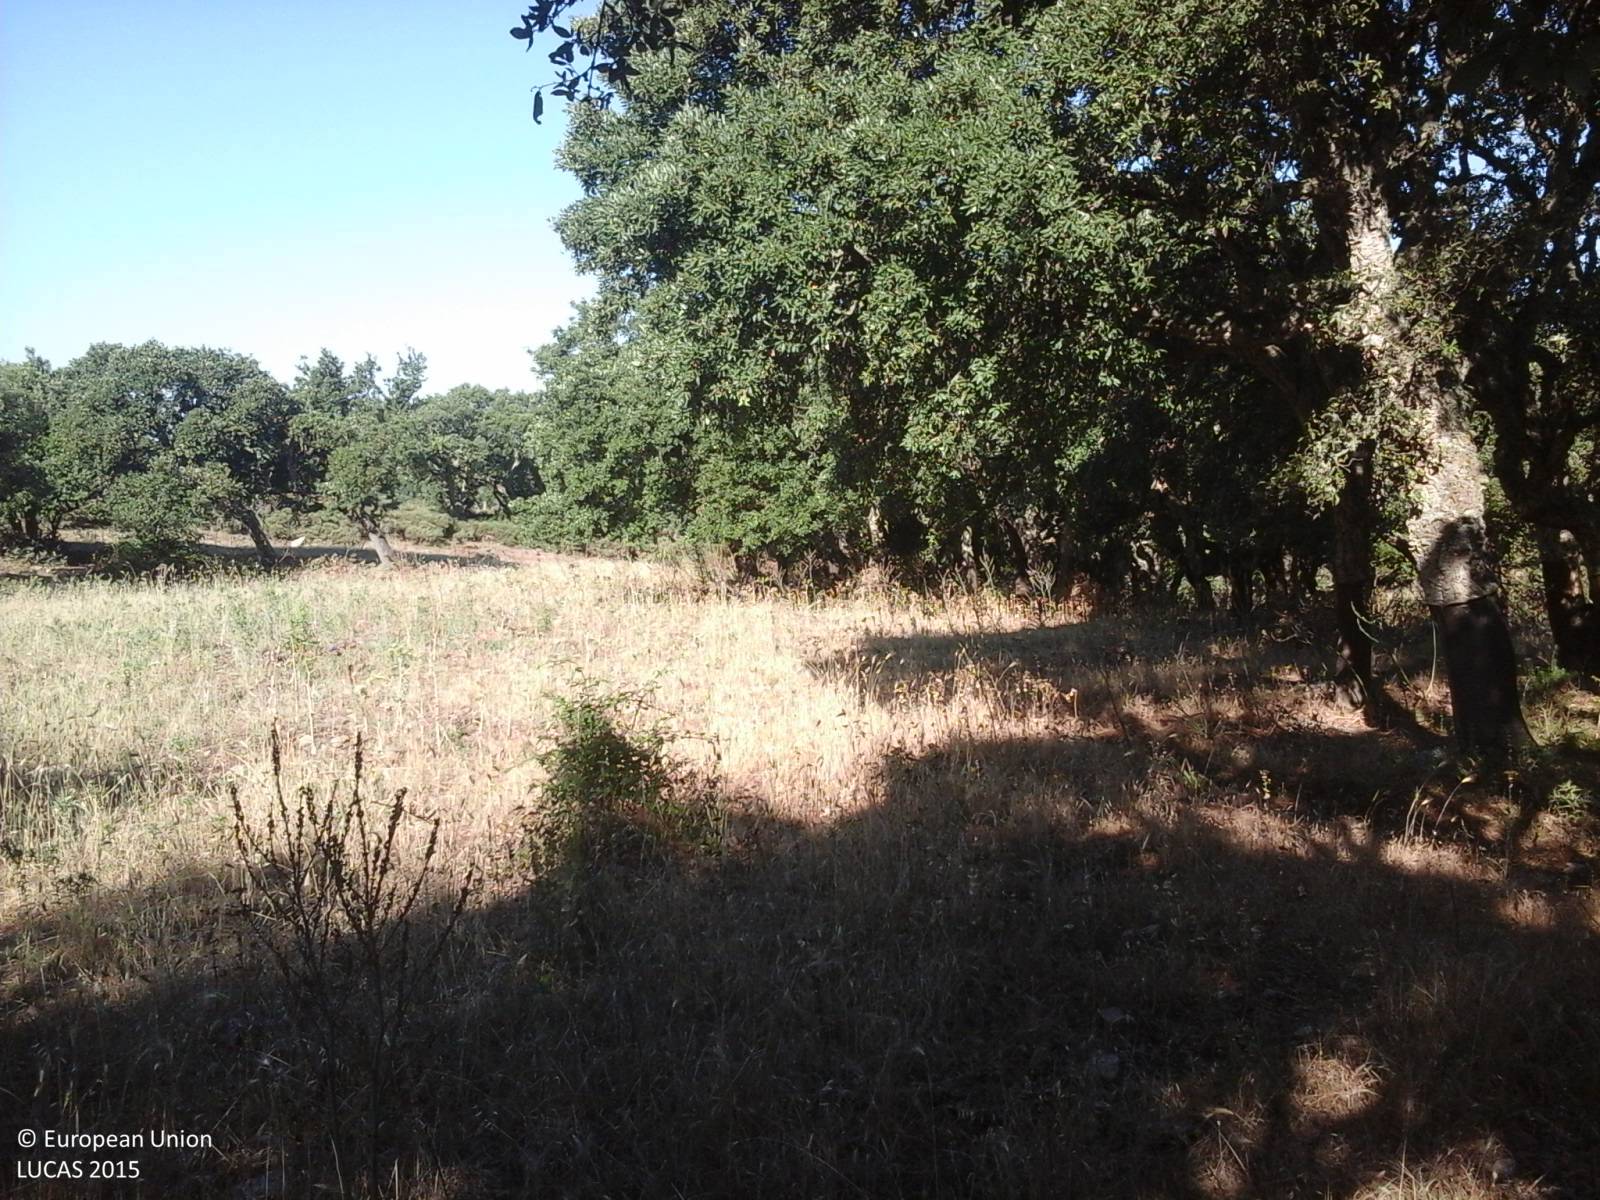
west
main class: Woodland
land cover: Broadleaved woodland
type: broadleaved evergreen forest
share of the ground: > 75 %
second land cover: Grassland without tree/shrub cover
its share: < 10 %
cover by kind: broadleaved forest trees 95 %, herbaceous plants 5 %
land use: Forestry
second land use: Agriculture (excluding fallow land and kitchen gardens)
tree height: > 5 m
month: July
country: IT
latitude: 40.5551
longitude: 9.4007
